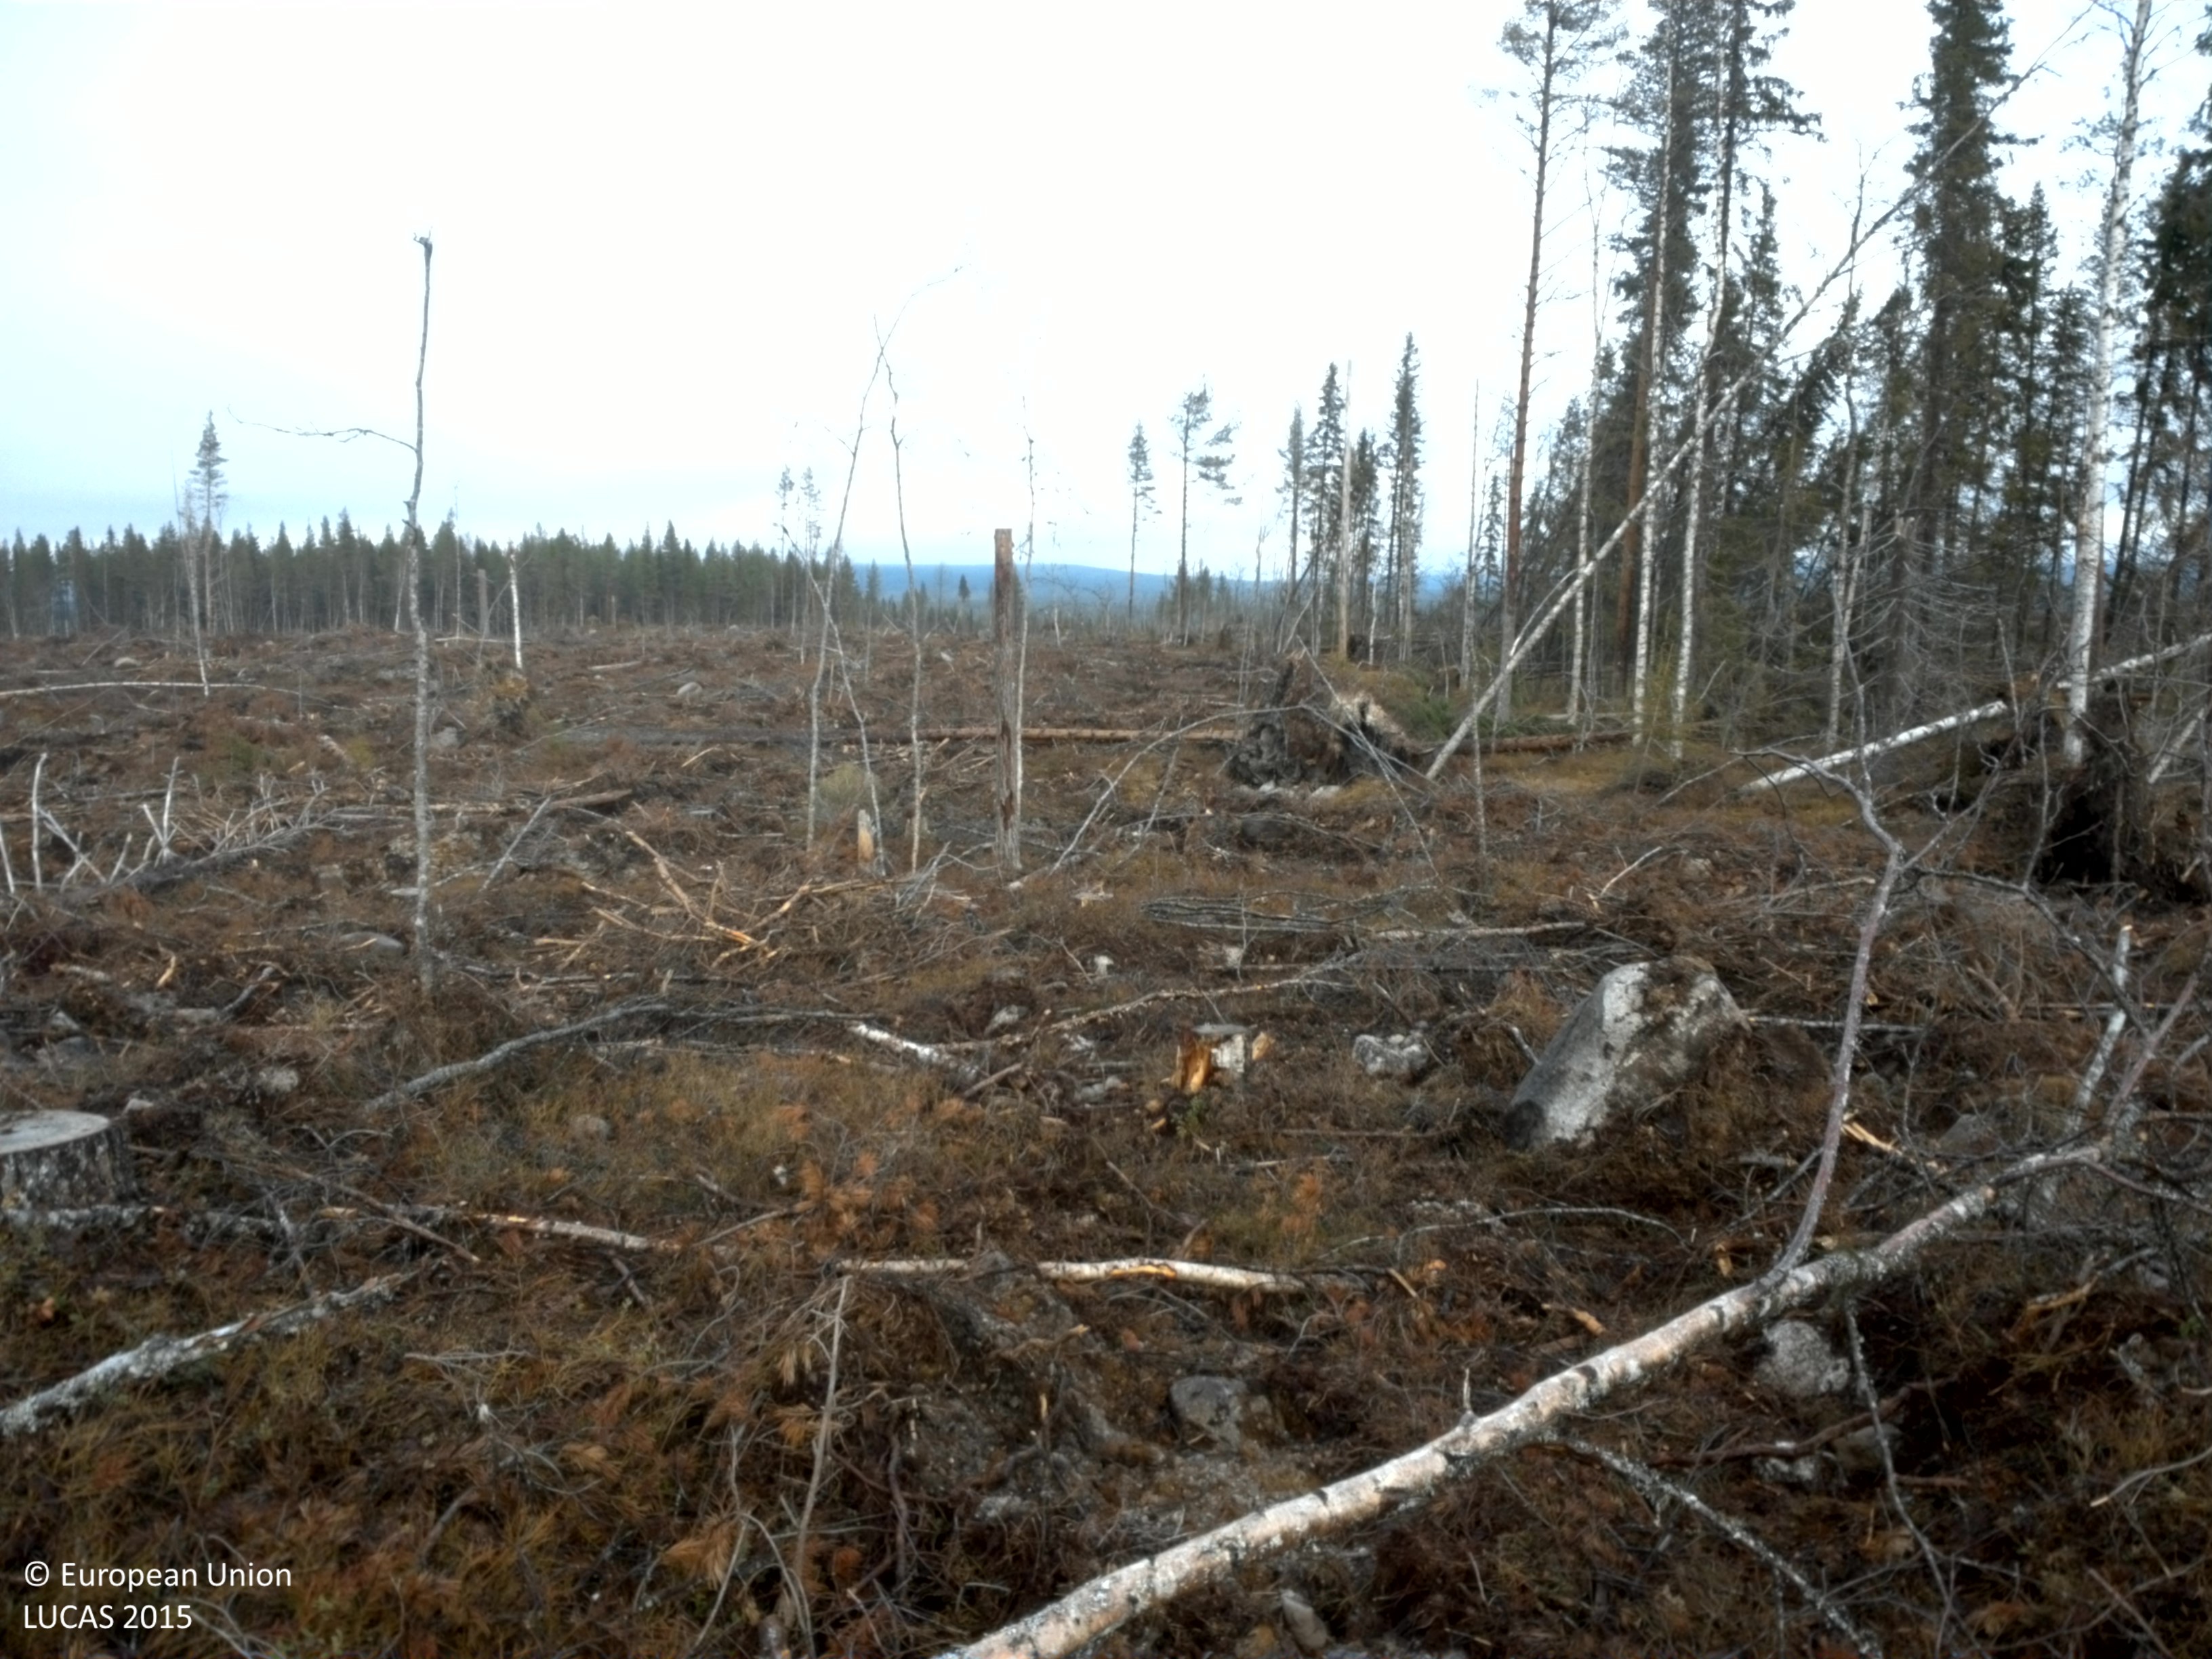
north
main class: Shrubland
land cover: Shrubland with sparse tree cover
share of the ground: 25 - 50 %
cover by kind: shrubs 35 %, unconsolidated bare surface 15 %, herbaceous plants 10 %, lichens and mosses 10 %, broadleaved forest trees 5 %, consolidated bare surface 5 %
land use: Forestry
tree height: < 5 m
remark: Clear cut
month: October
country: SE
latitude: 64.3995
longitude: 16.7509
